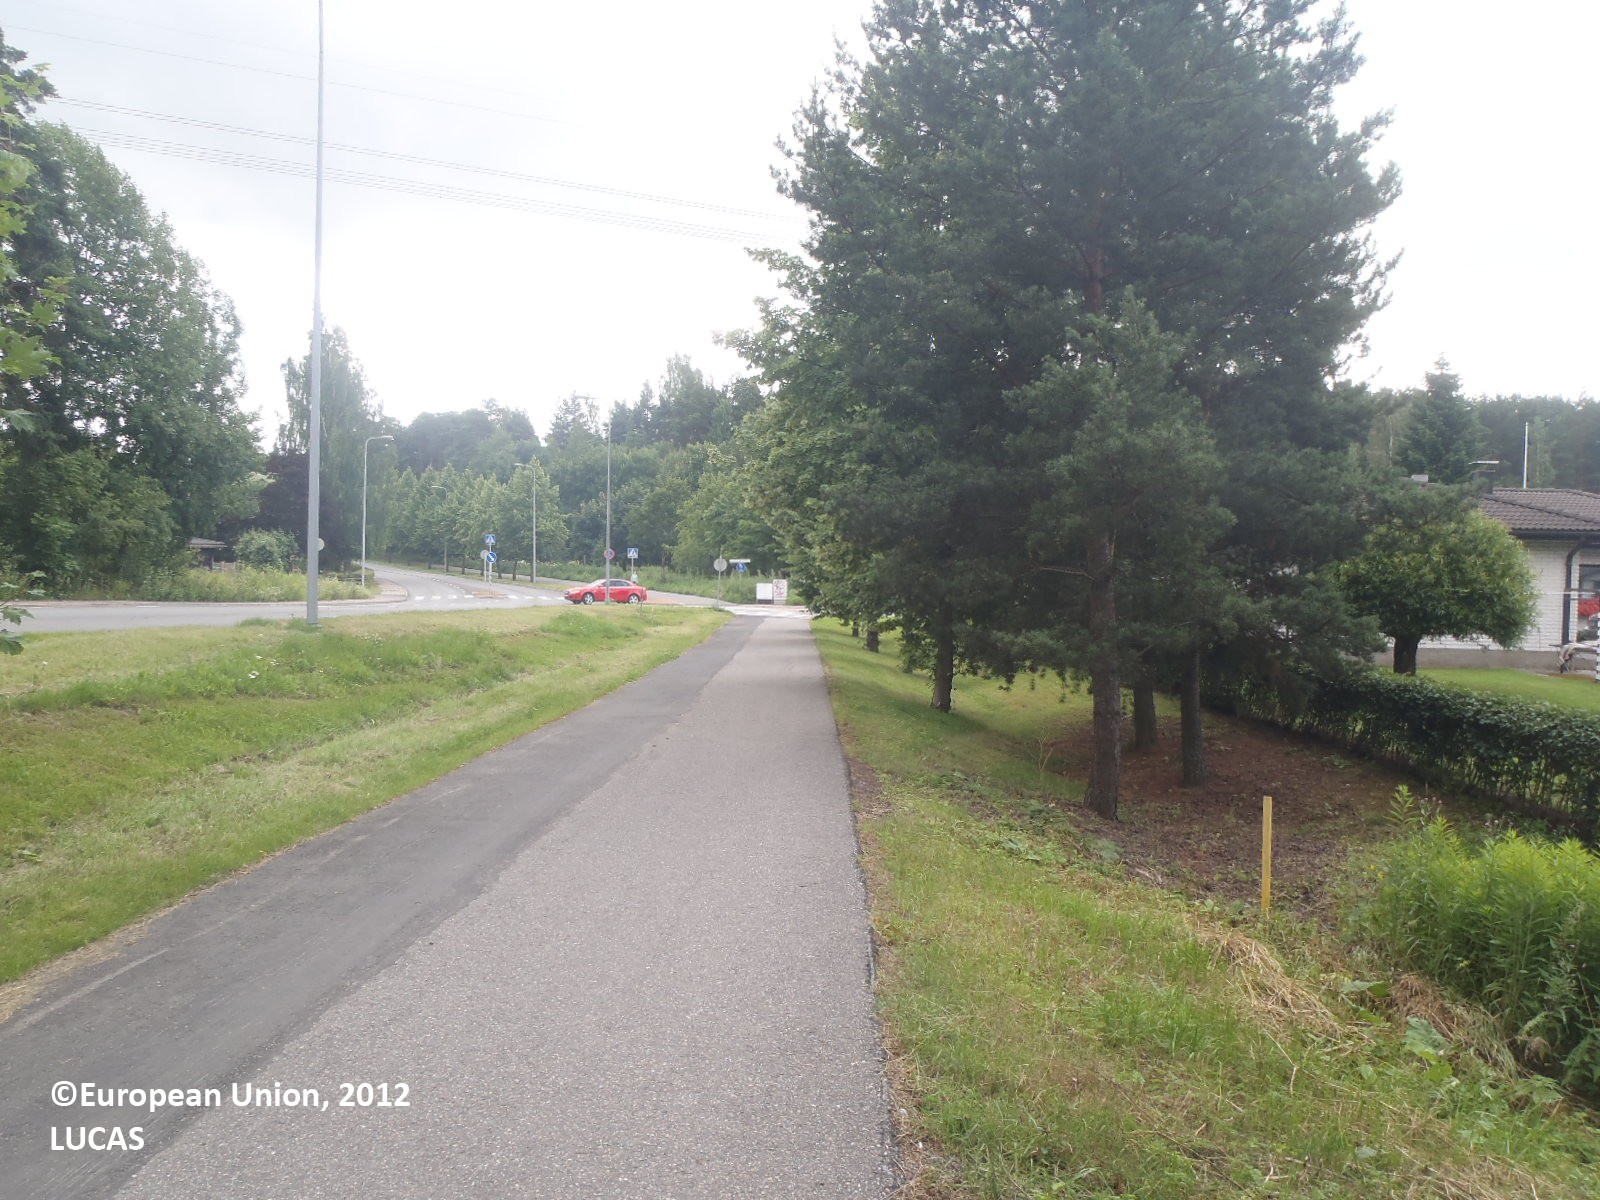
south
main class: Grassland
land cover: Grassland with sparse tree/shrub cover
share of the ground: > 75 %
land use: Residential
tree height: > 5 m
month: July
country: FI
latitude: 60.4671
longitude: 22.2337
